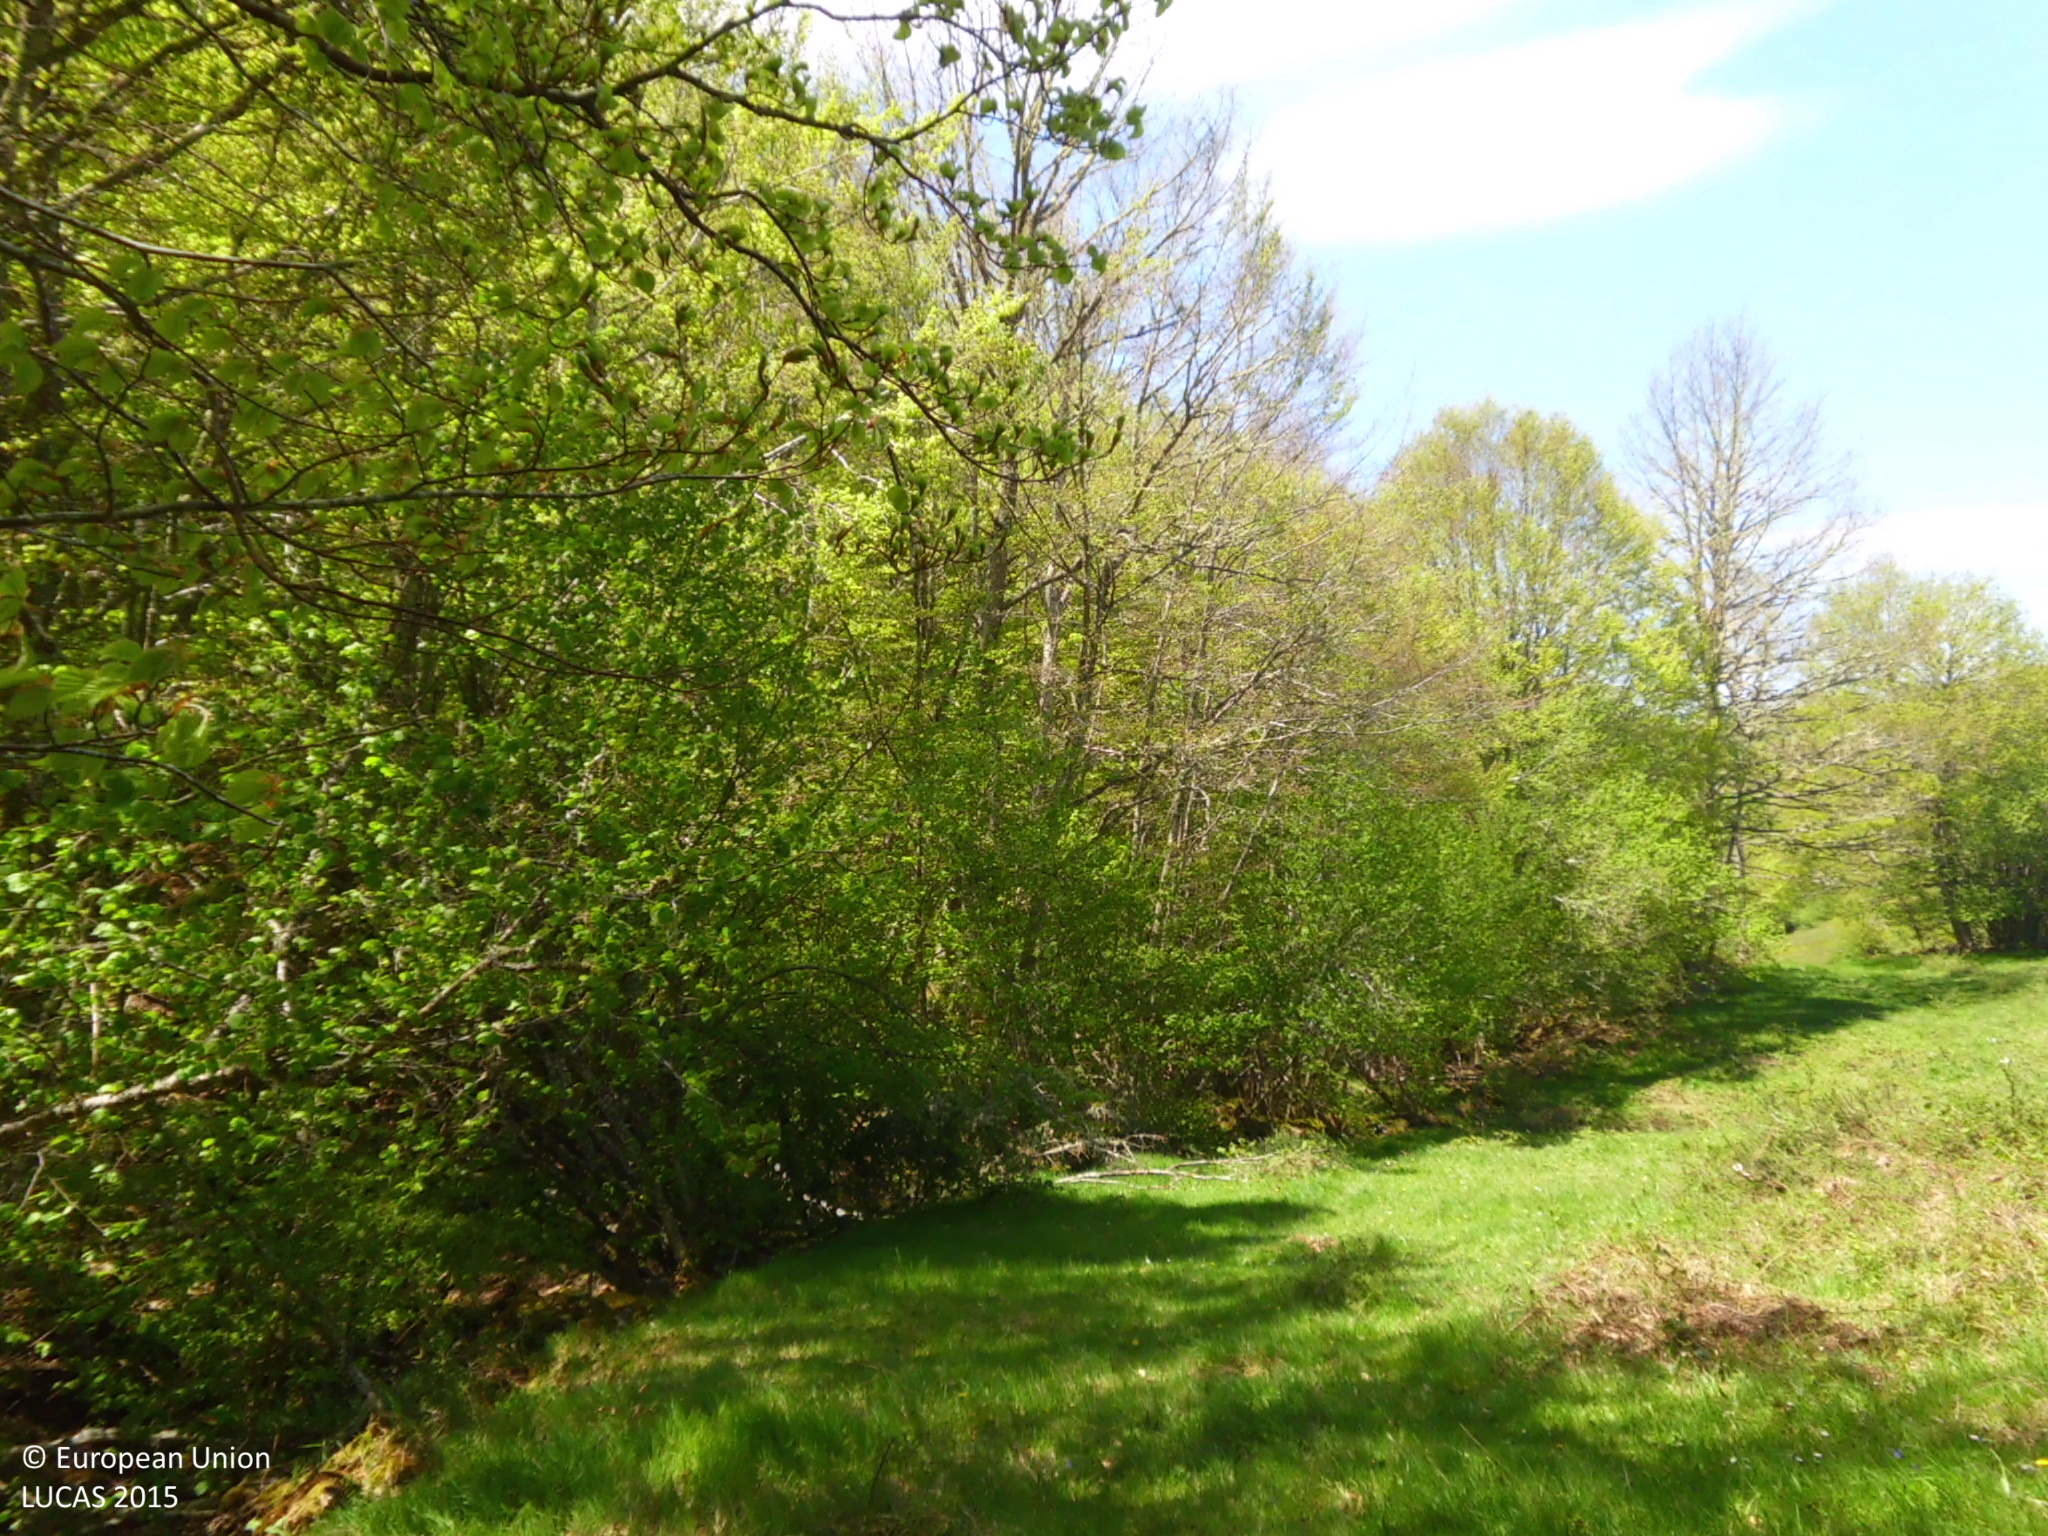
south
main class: Woodland
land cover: Broadleaved woodland
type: acidophilous oak and oak-birch forest
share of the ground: 50 - 75 %
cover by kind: broadleaved forest trees 70 %, shrubs 20 %, herbaceous plants 10 %
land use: Semi-natural and natural areas not in use
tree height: > 5 m
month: May
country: ES
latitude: 42.9027
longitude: -3.9966
